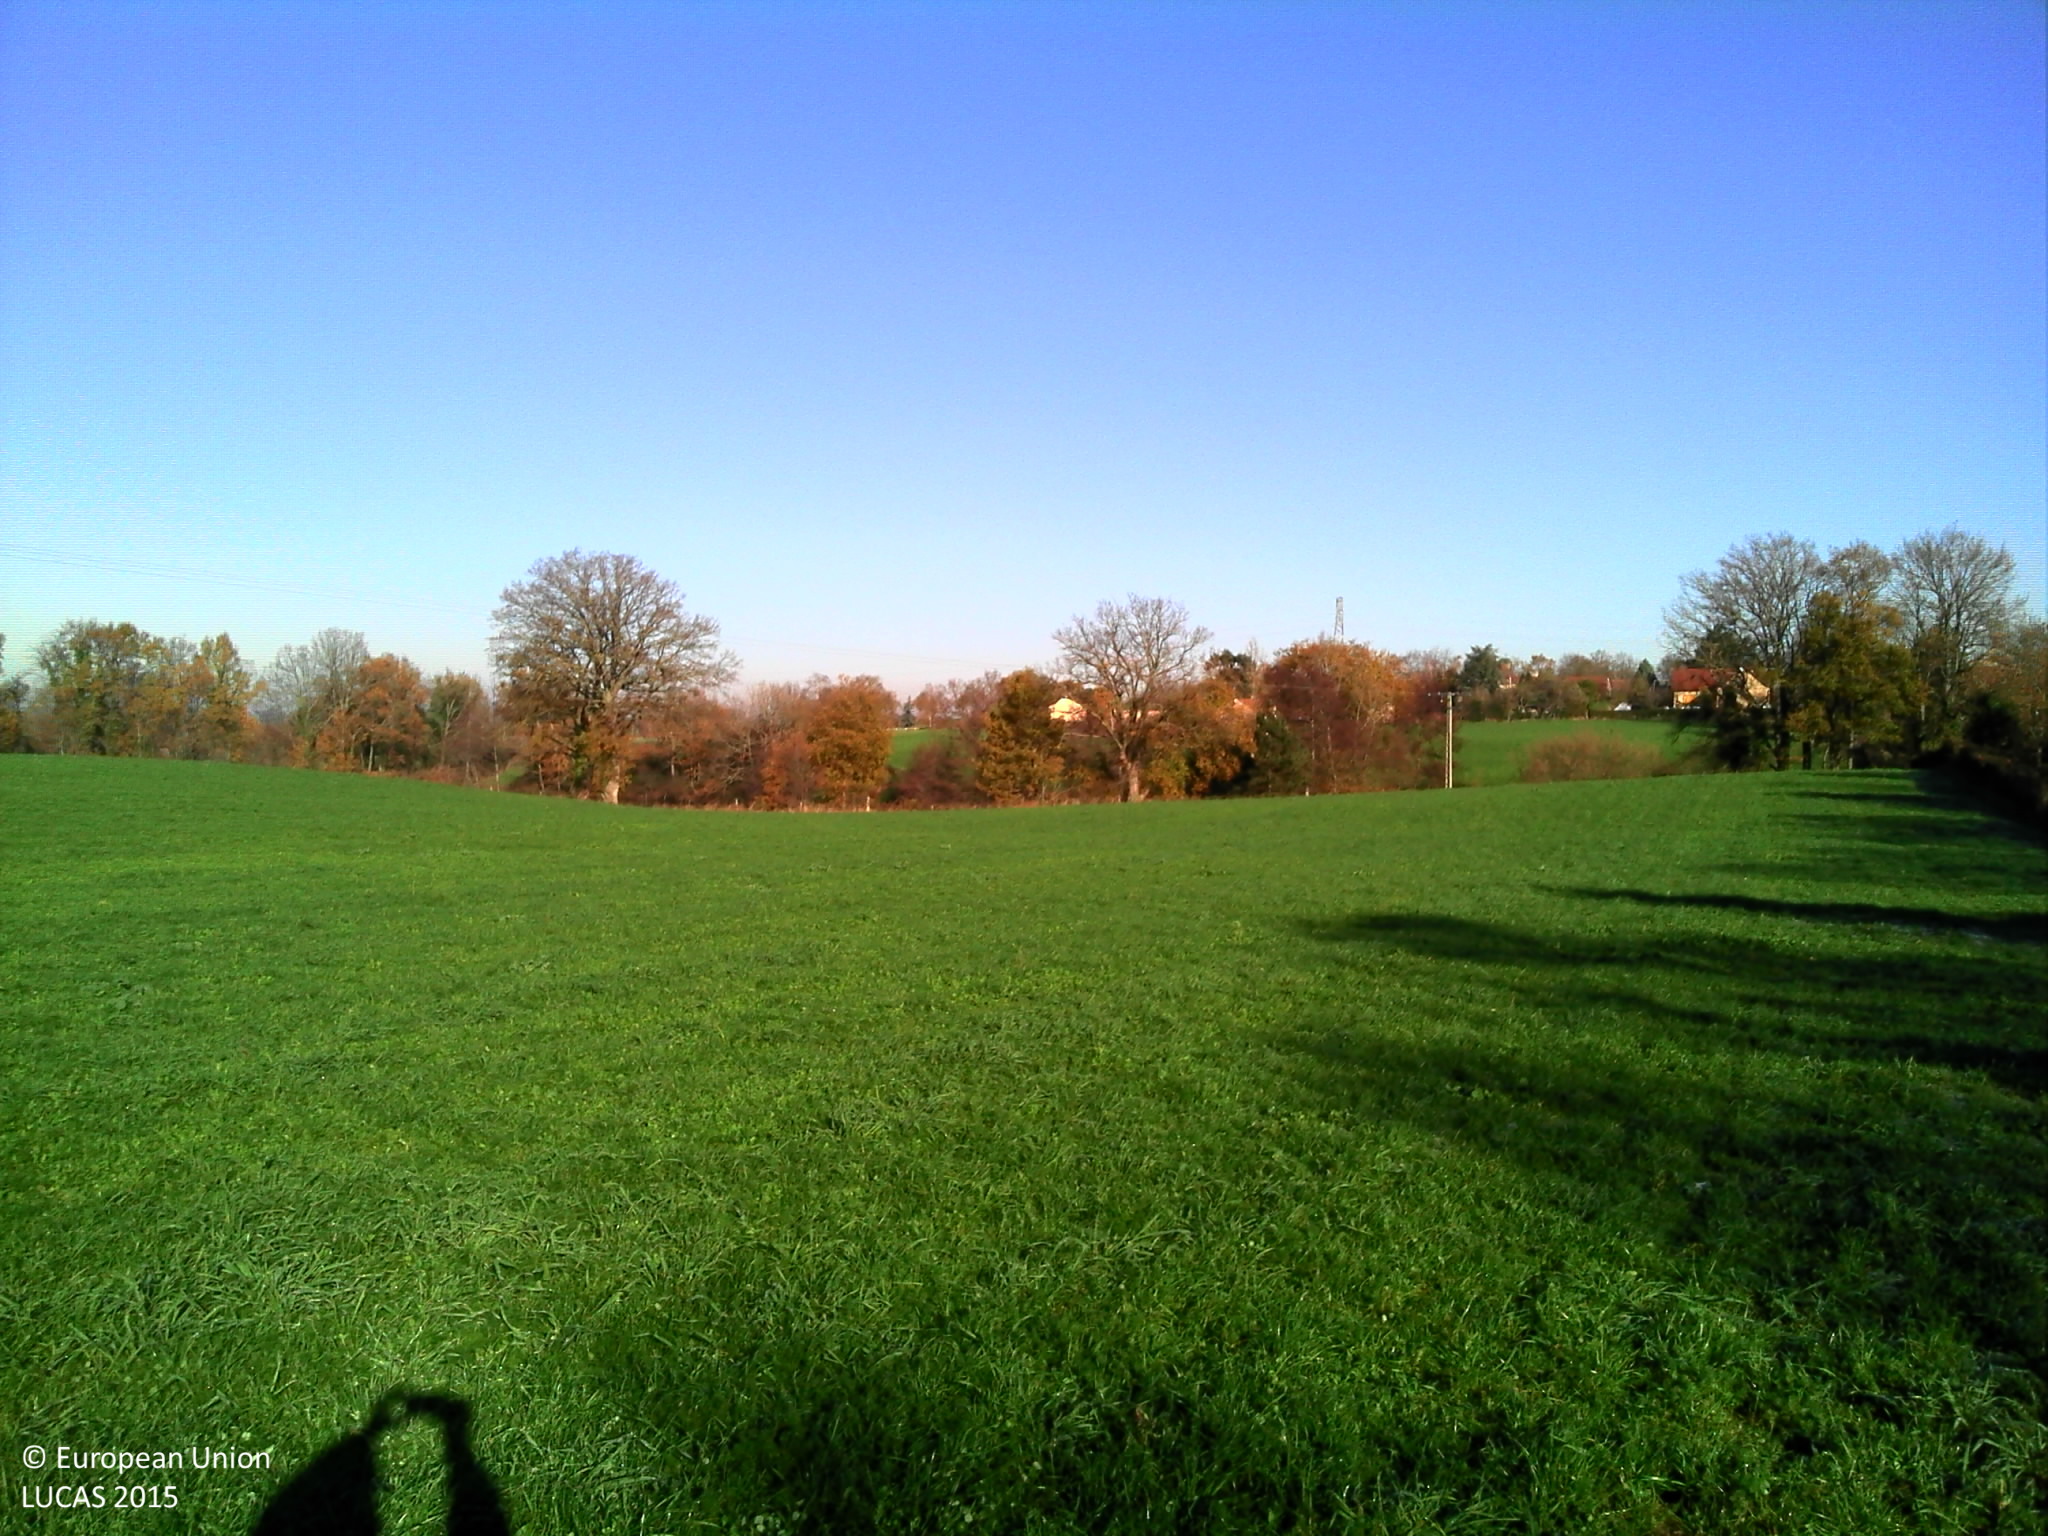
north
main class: Cropland
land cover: Temporary grasslands
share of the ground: > 75 %
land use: Agriculture (excluding fallow land and kitchen gardens)
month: May
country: FR
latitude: 46.3049
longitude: 2.7648
